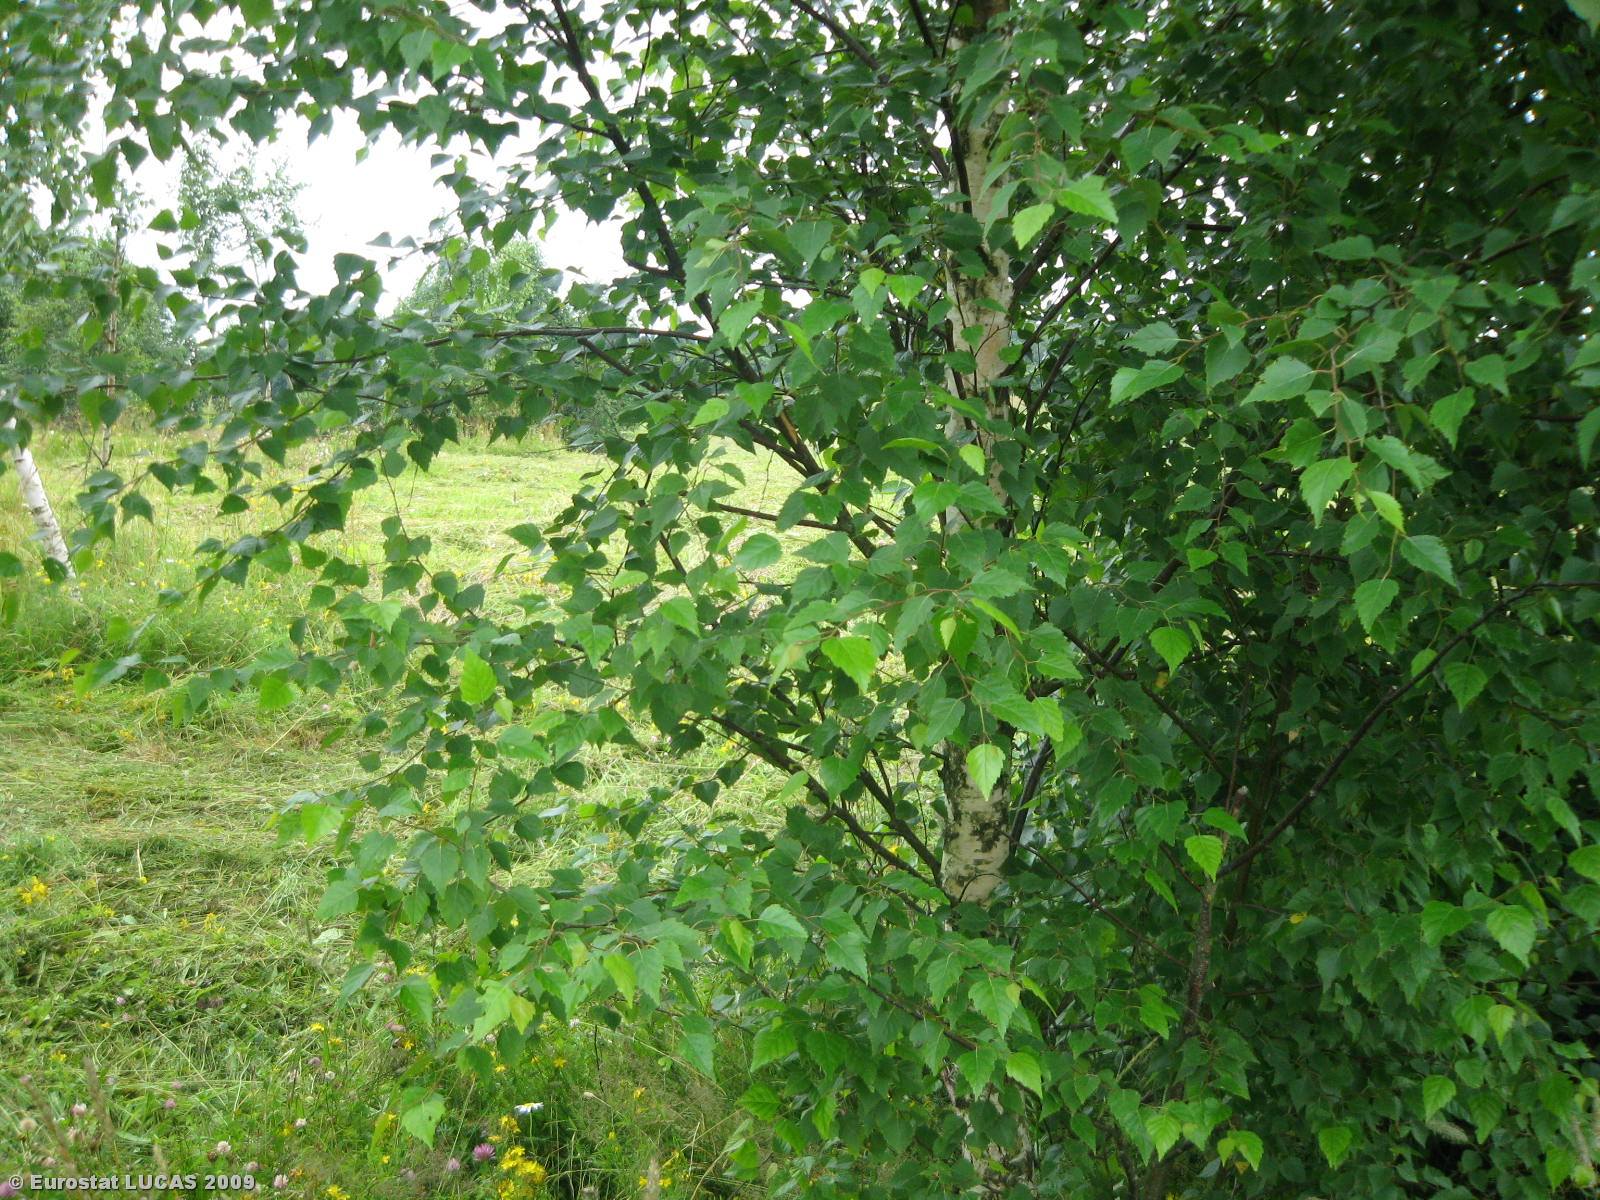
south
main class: Woodland
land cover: Broadleaved woodland
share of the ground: 25 - 50 %
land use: Forestry
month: July
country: LT
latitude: 55.2226
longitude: 24.8710
